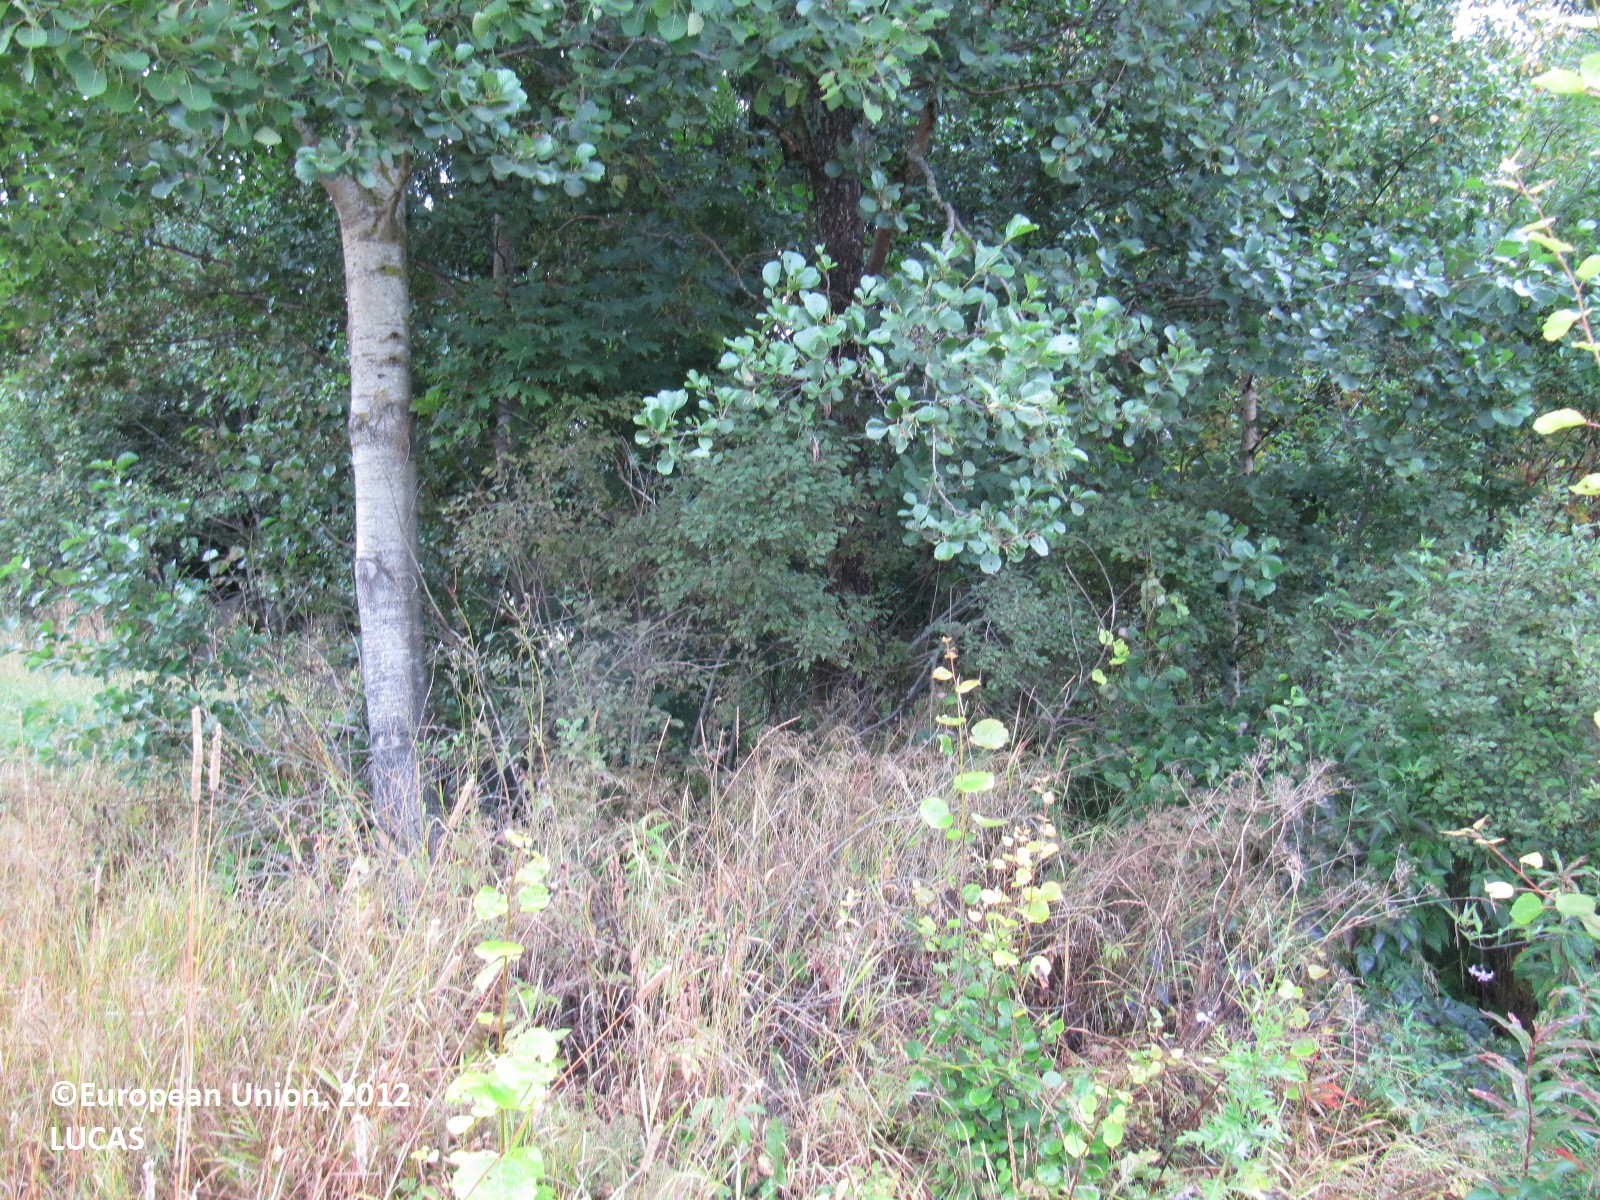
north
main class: Grassland
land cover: Spontaneously vegetated surfaces
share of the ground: > 75 %
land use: Agriculture (excluding fallow land and kitchen gardens)
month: August
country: FI
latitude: 60.1986
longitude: 24.3005
